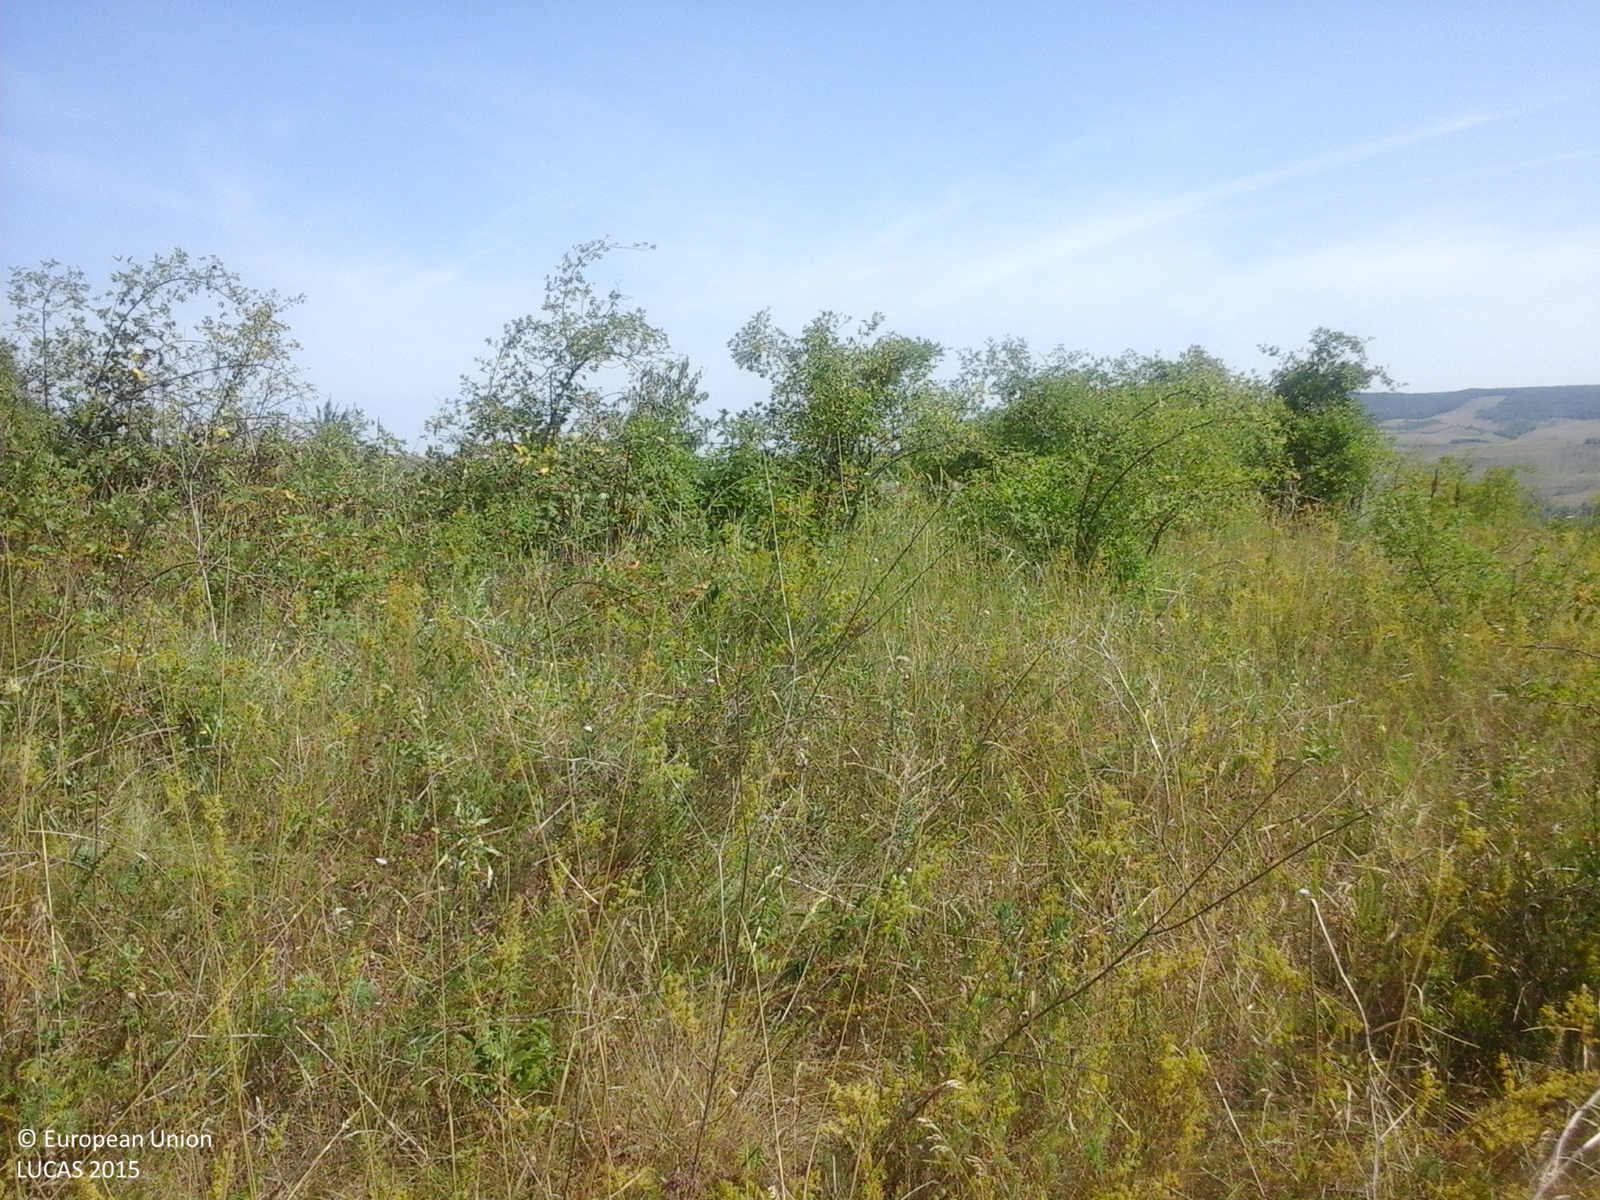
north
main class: Shrubland
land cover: Shrubland with sparse tree cover
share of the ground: > 75 %
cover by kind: shrubs 75 %, herbaceous plants 20 %, broadleaved forest trees 5 %
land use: Semi-natural and natural areas not in use
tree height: > 5 m
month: July
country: RO
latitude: 46.5412
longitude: 27.2244
